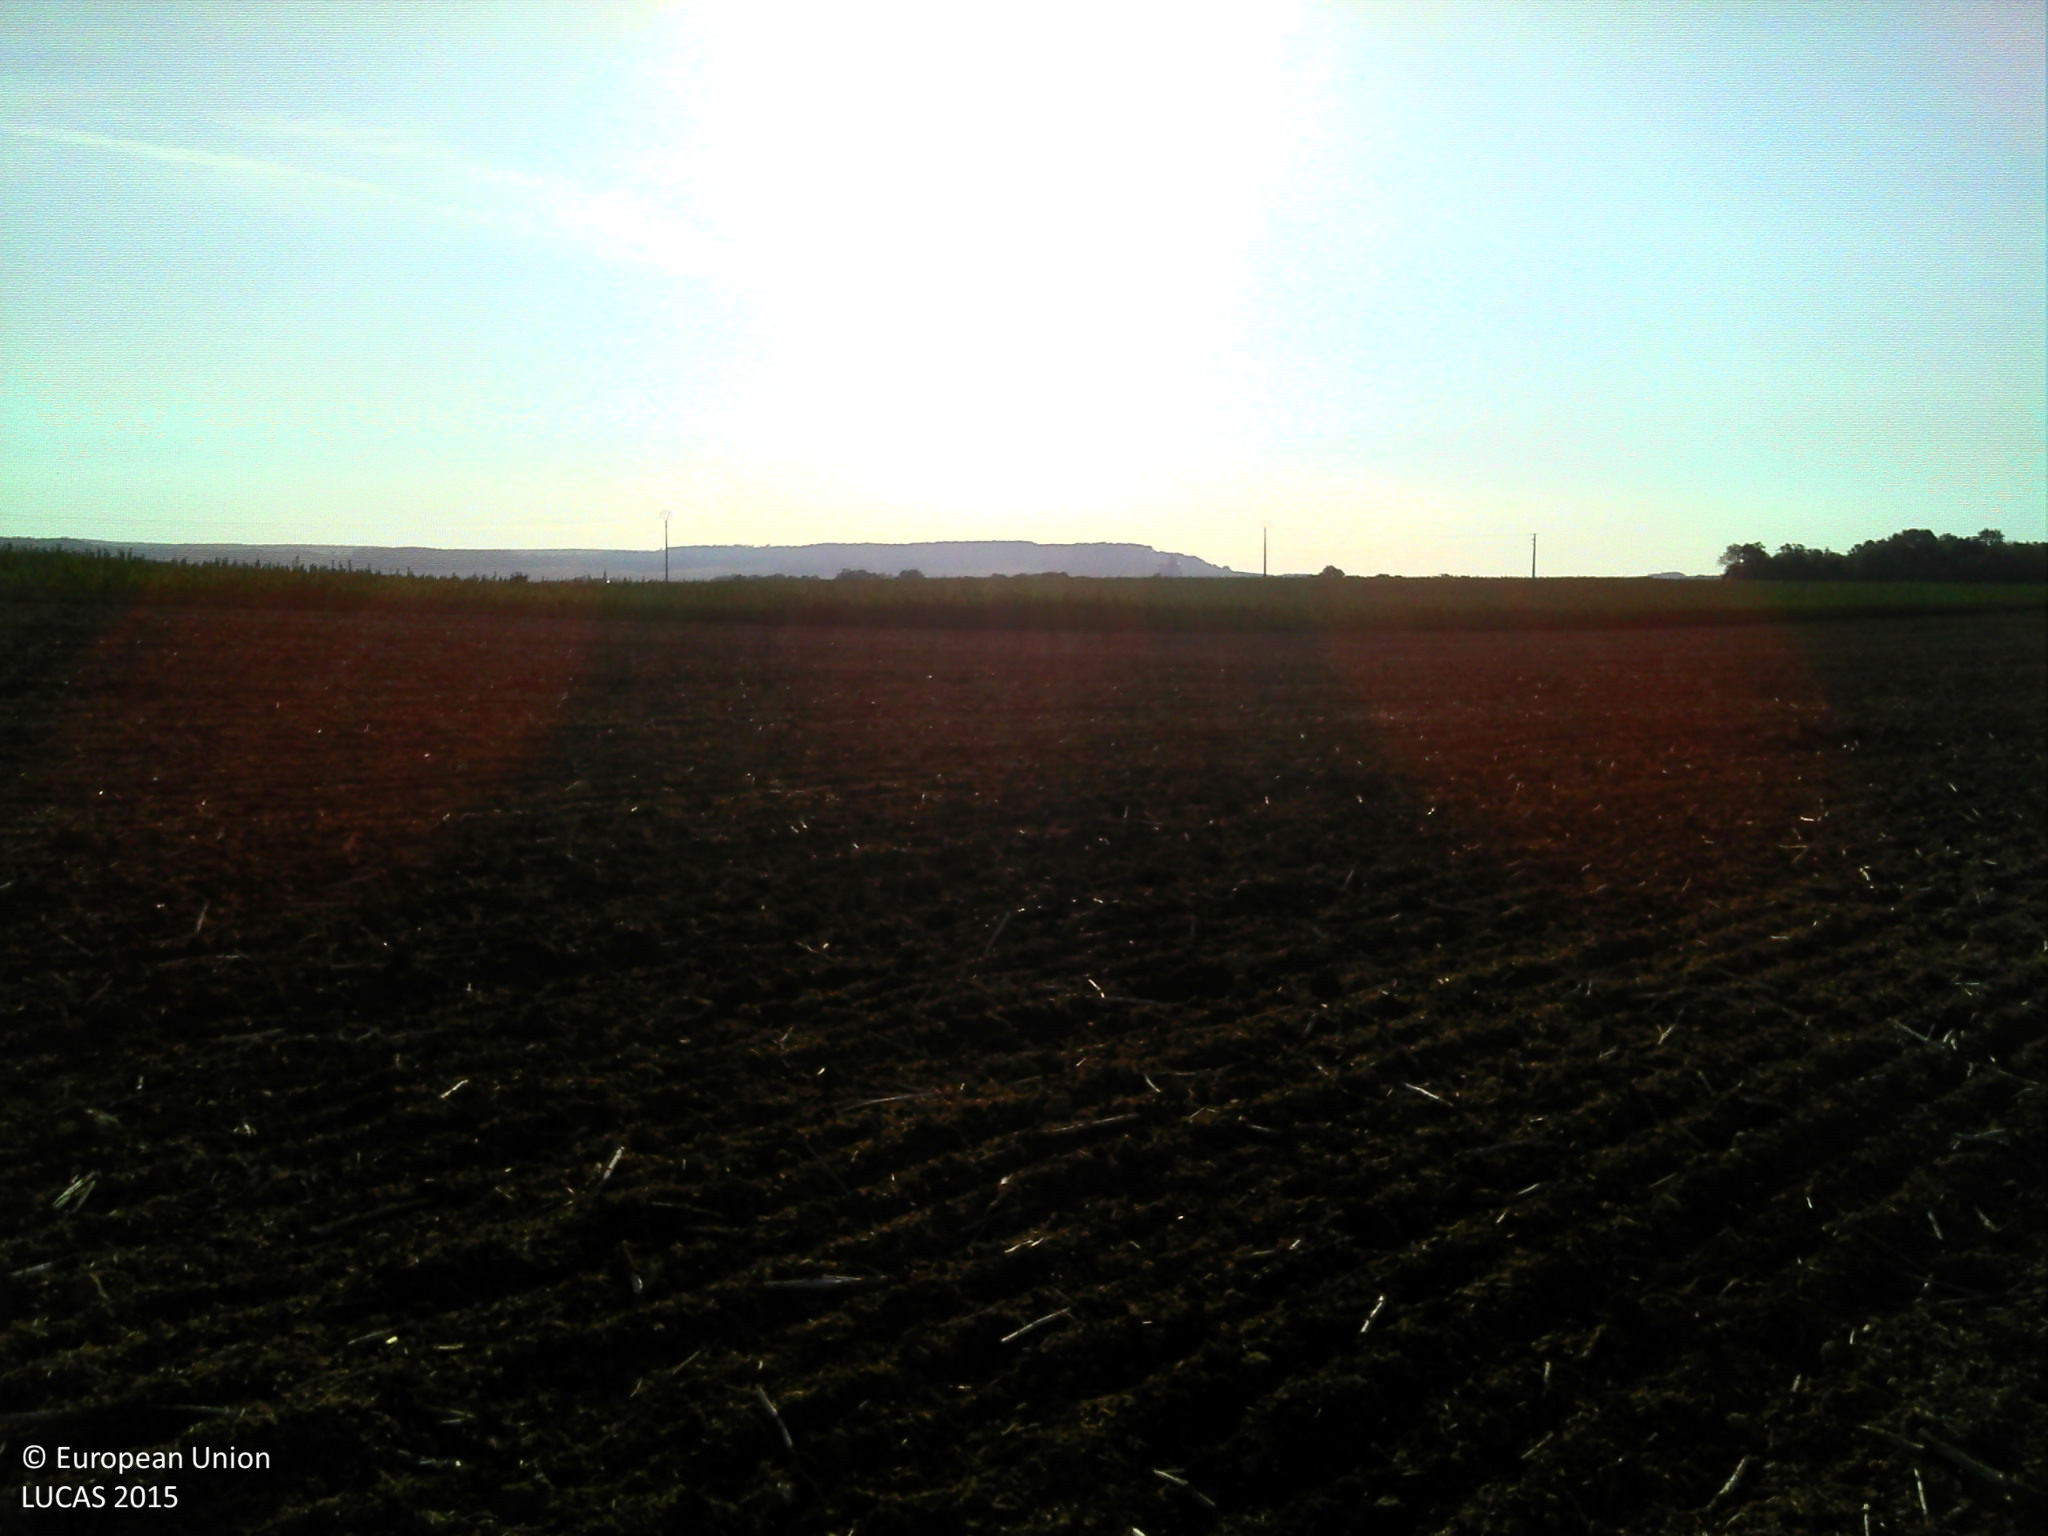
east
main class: Cropland
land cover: Rape and turnip rape
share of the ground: < 10 %
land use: Agriculture (excluding fallow land and kitchen gardens)
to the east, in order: Rape and turnip rape; Other fibre and oleaginous crops
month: August
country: FR
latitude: 47.9125
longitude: 4.6331
